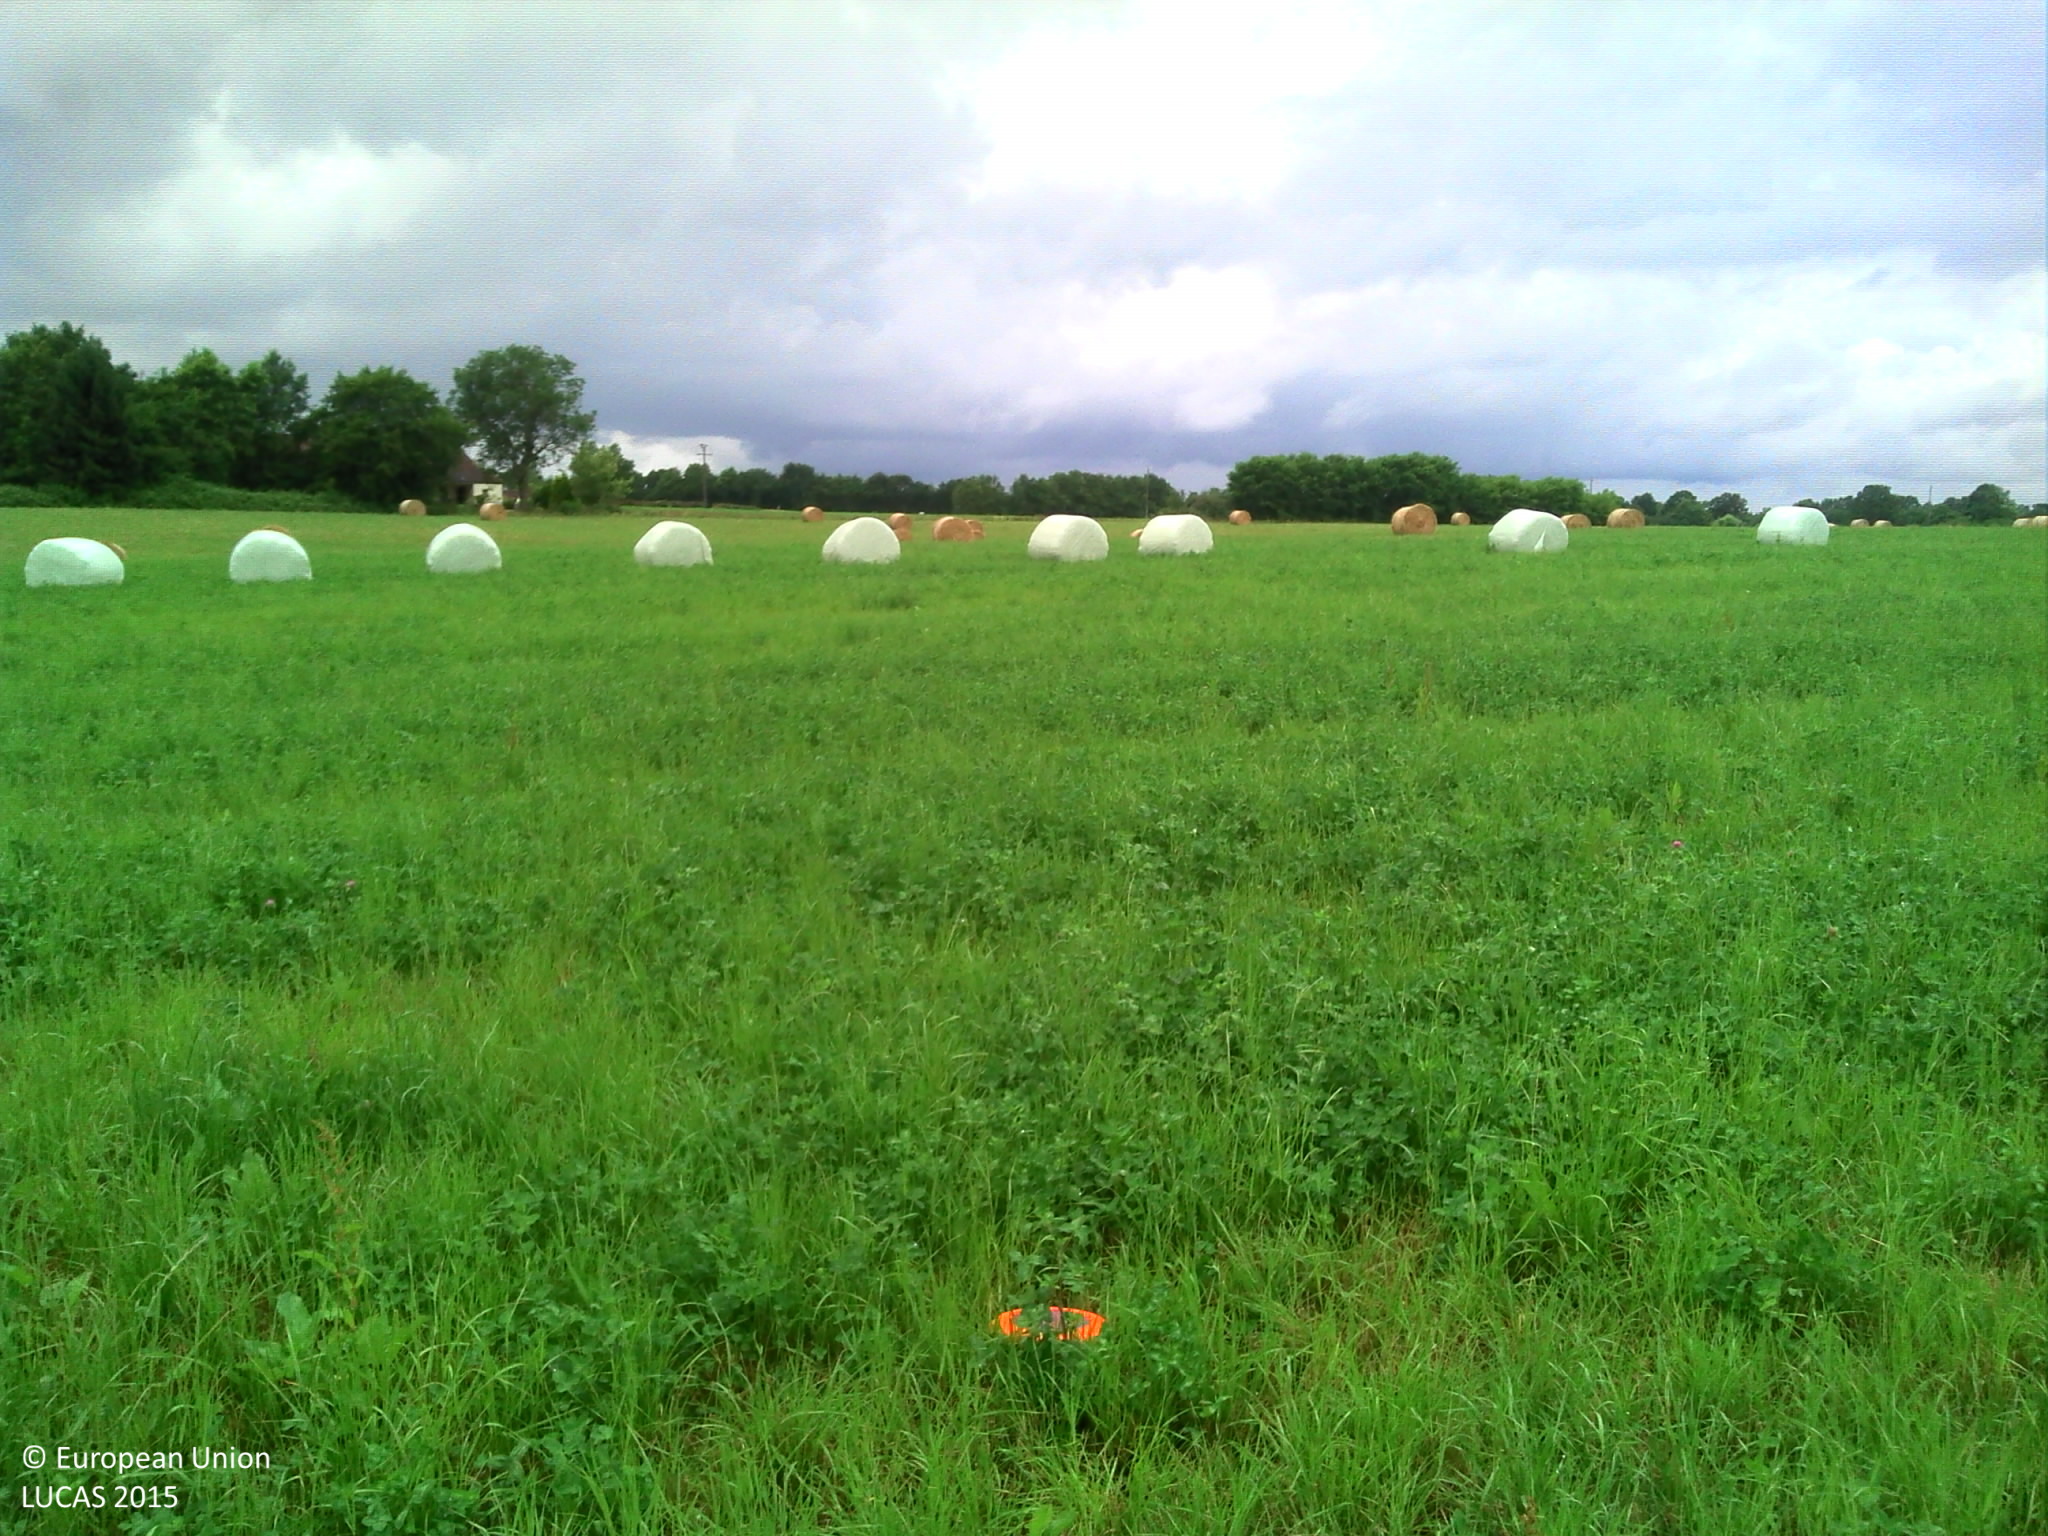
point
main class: Cropland
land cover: Clovers
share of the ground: 50 - 75 %
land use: Agriculture (excluding fallow land and kitchen gardens)
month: June
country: FR
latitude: 46.6633
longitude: 5.3102
